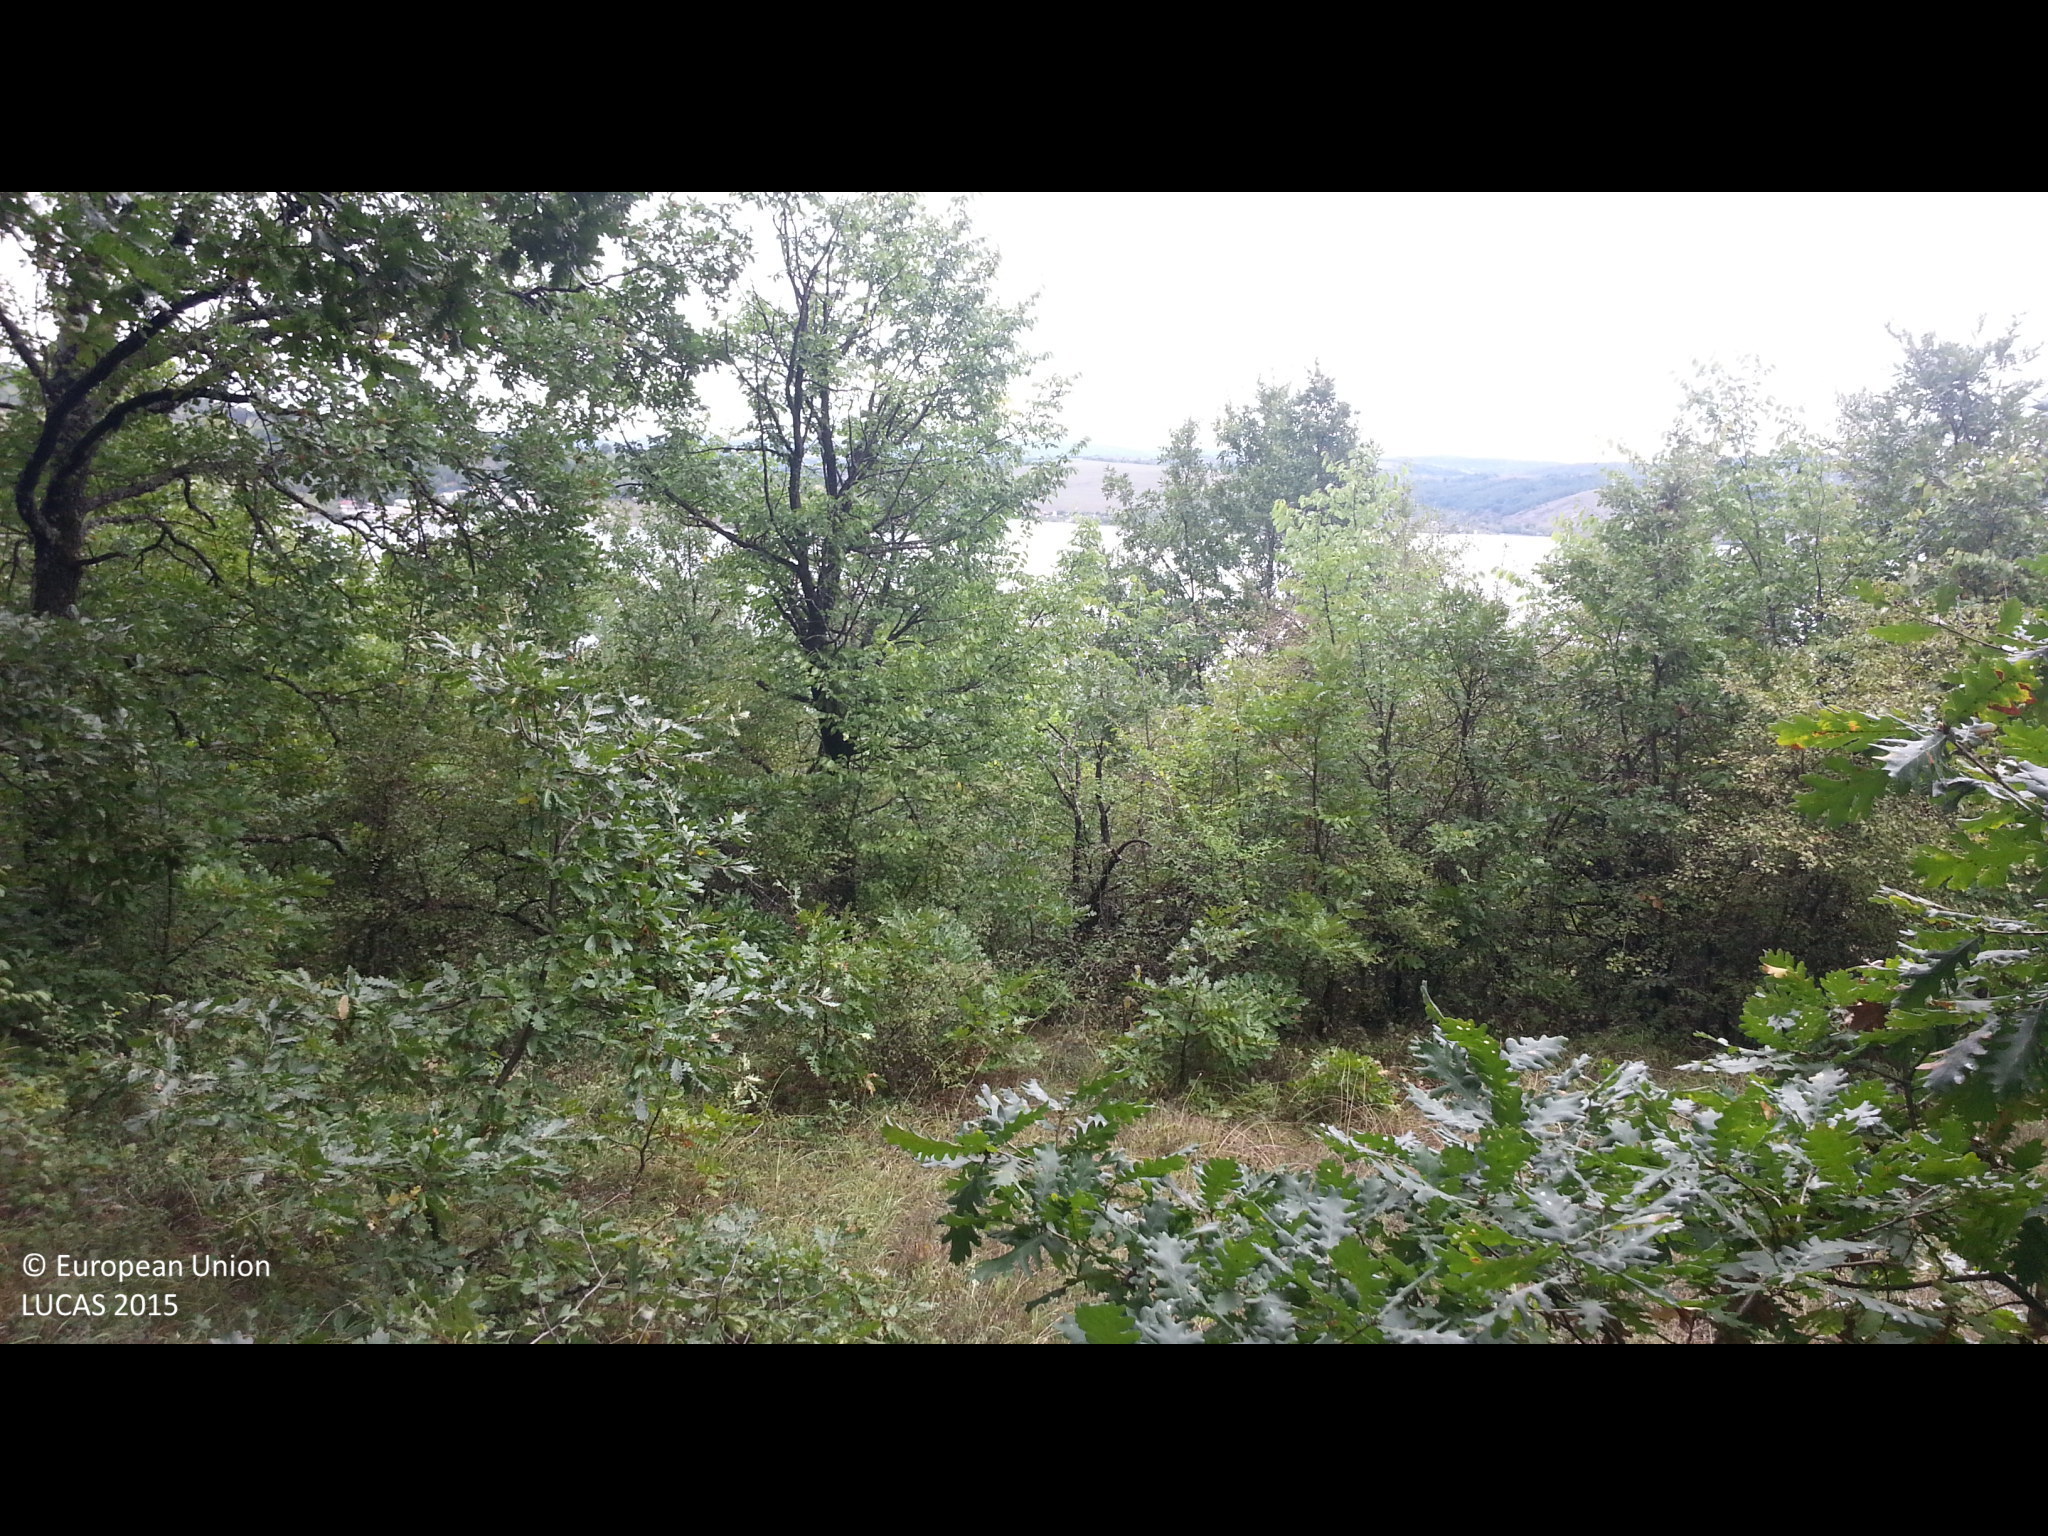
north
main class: Woodland
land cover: Broadleaved woodland
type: mesophytic deciduous forest
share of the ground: 50 - 75 %
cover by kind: broadleaved forest trees 70 %, herbaceous plants 25 %, shrubs 5 %
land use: Forestry
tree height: > 5 m
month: September
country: BG
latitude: 42.5086
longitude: 22.8410
